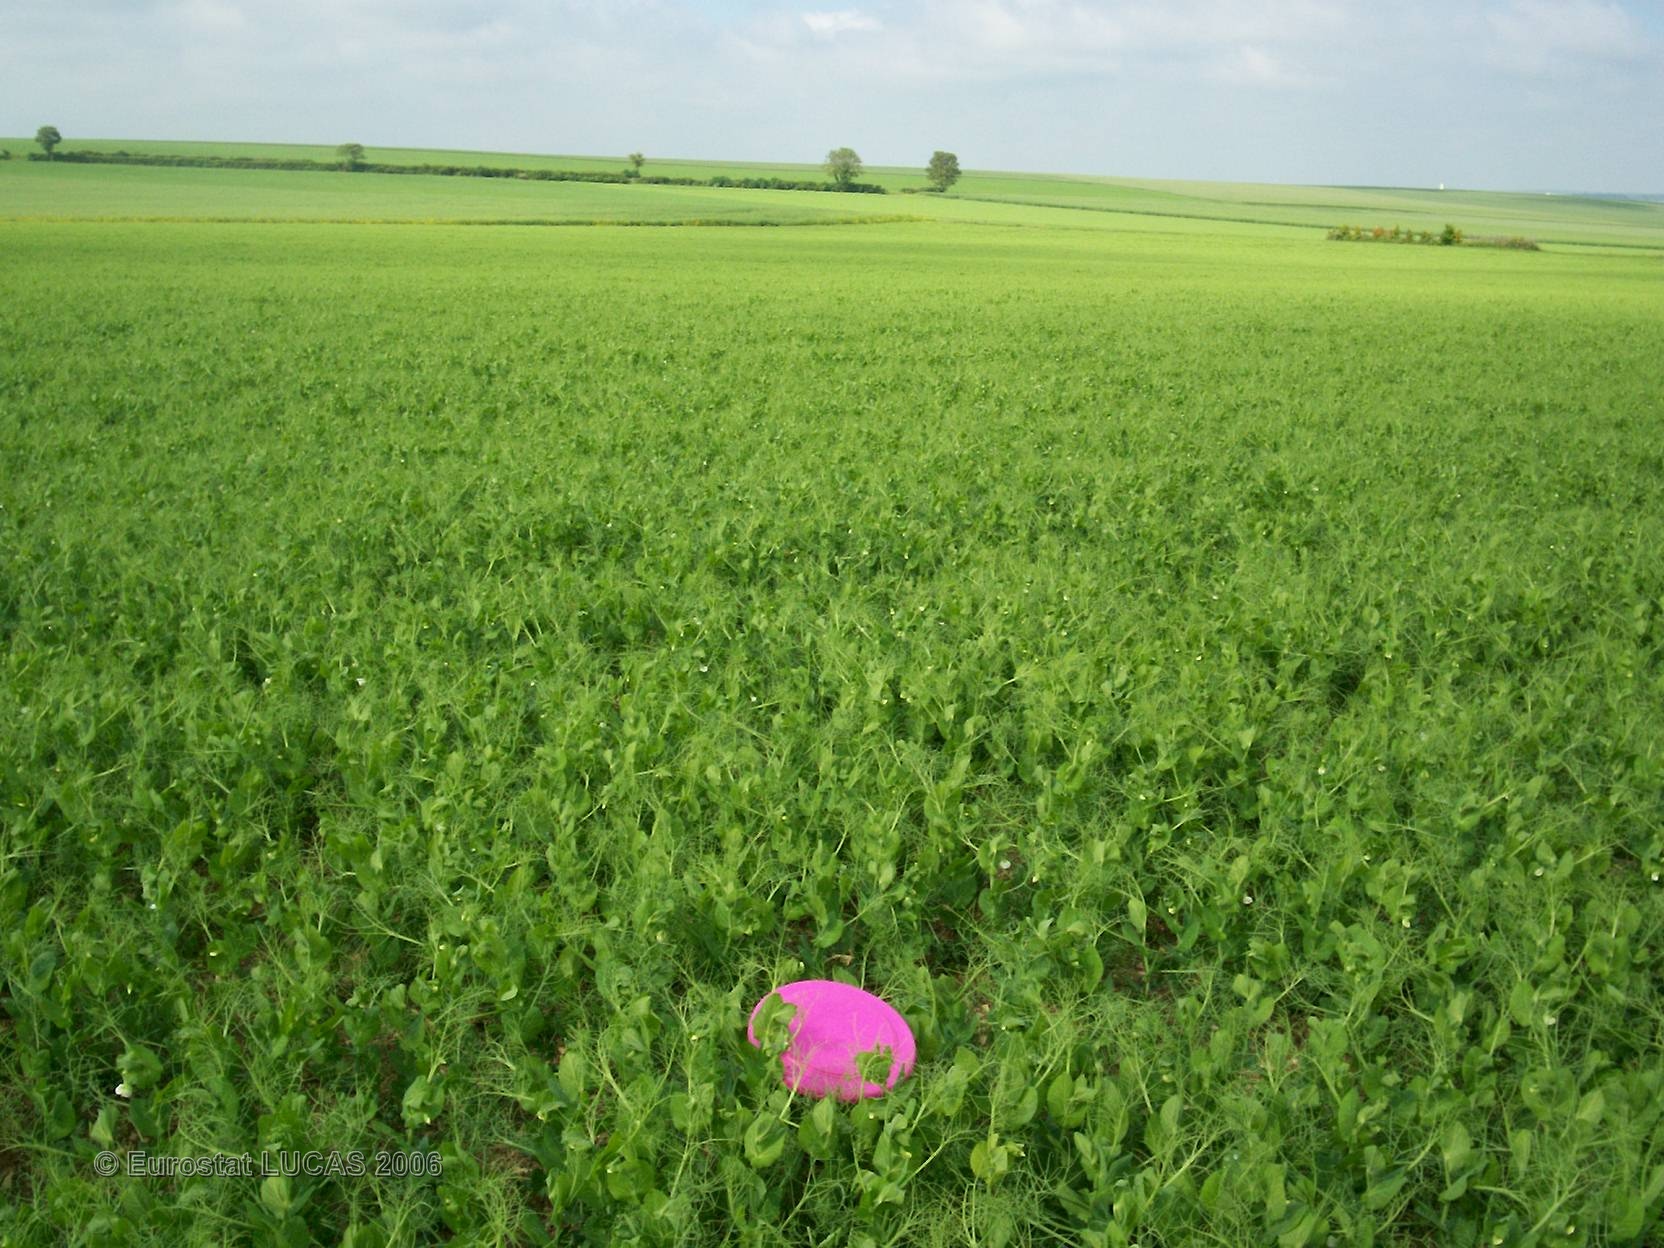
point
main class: Cropland
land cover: Dry pulses
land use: Agriculture (excluding fallow land and kitchen gardens)
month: June
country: FR
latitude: 48.5696
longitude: 4.4270
